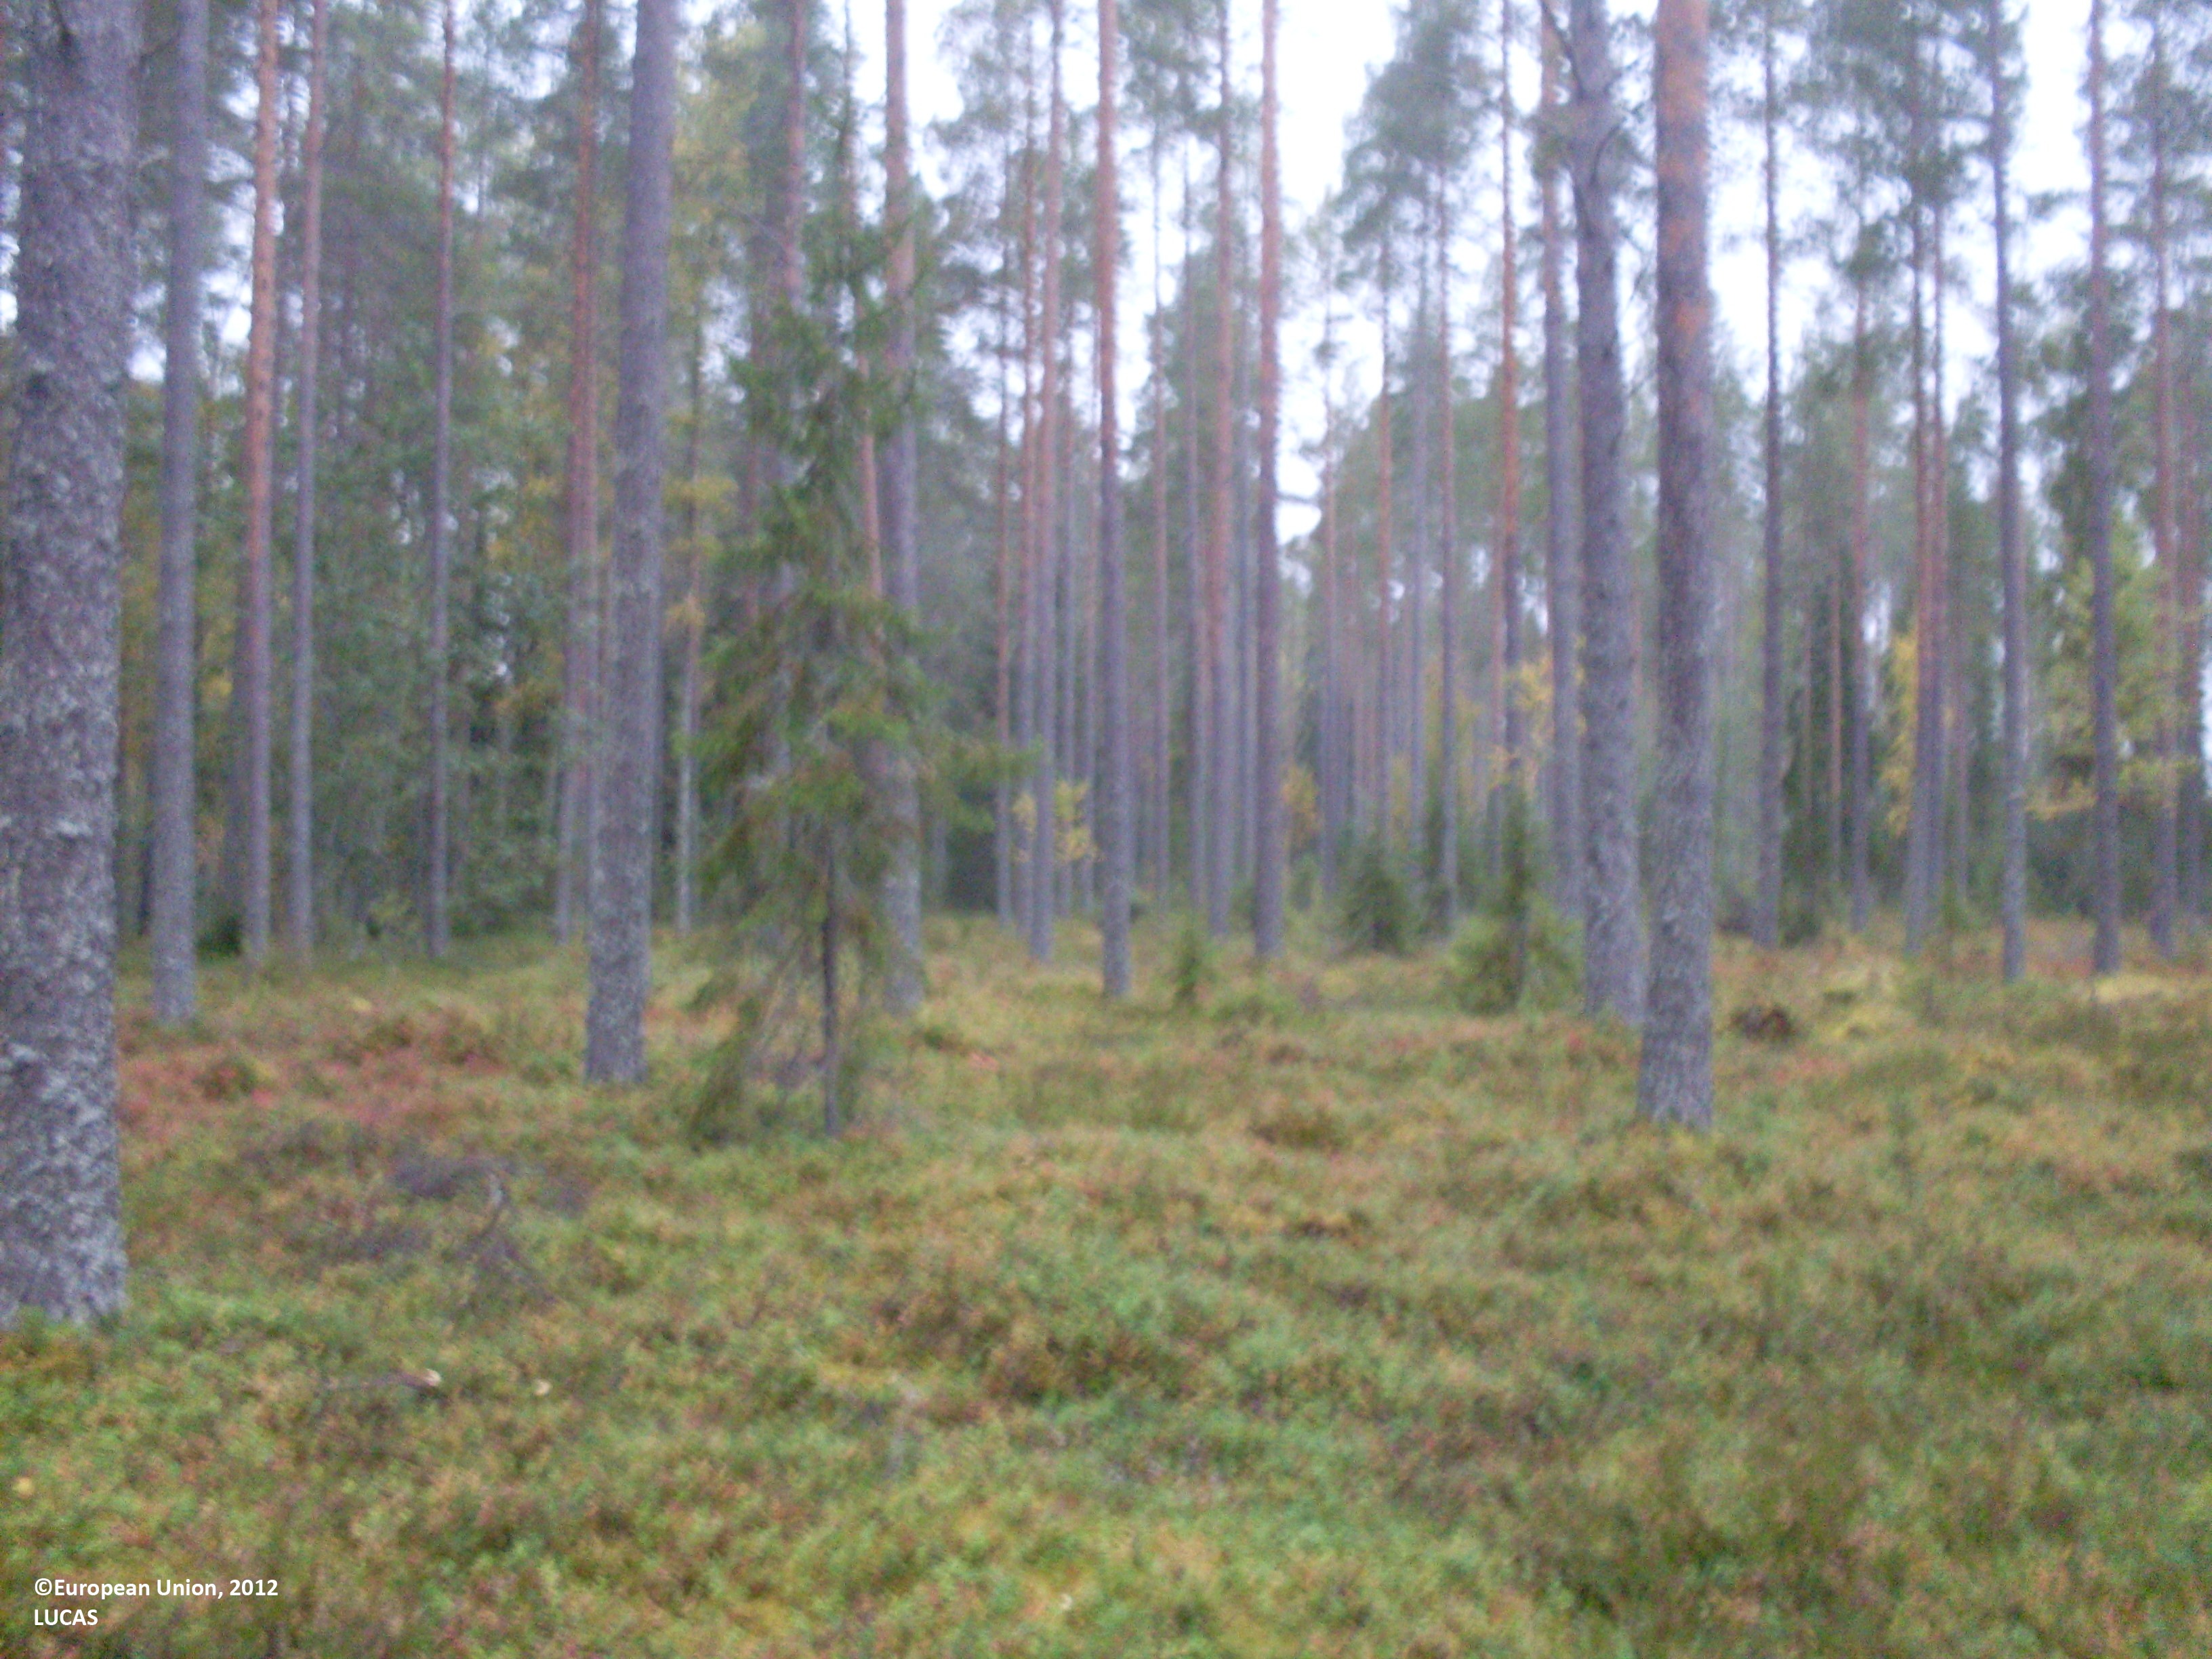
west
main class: Woodland
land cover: Pine dominated coniferous woodland
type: boreal forest
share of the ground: 25 - 50 %
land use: Forestry
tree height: > 5 m
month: September
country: FI
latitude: 64.1698
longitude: 28.9790
